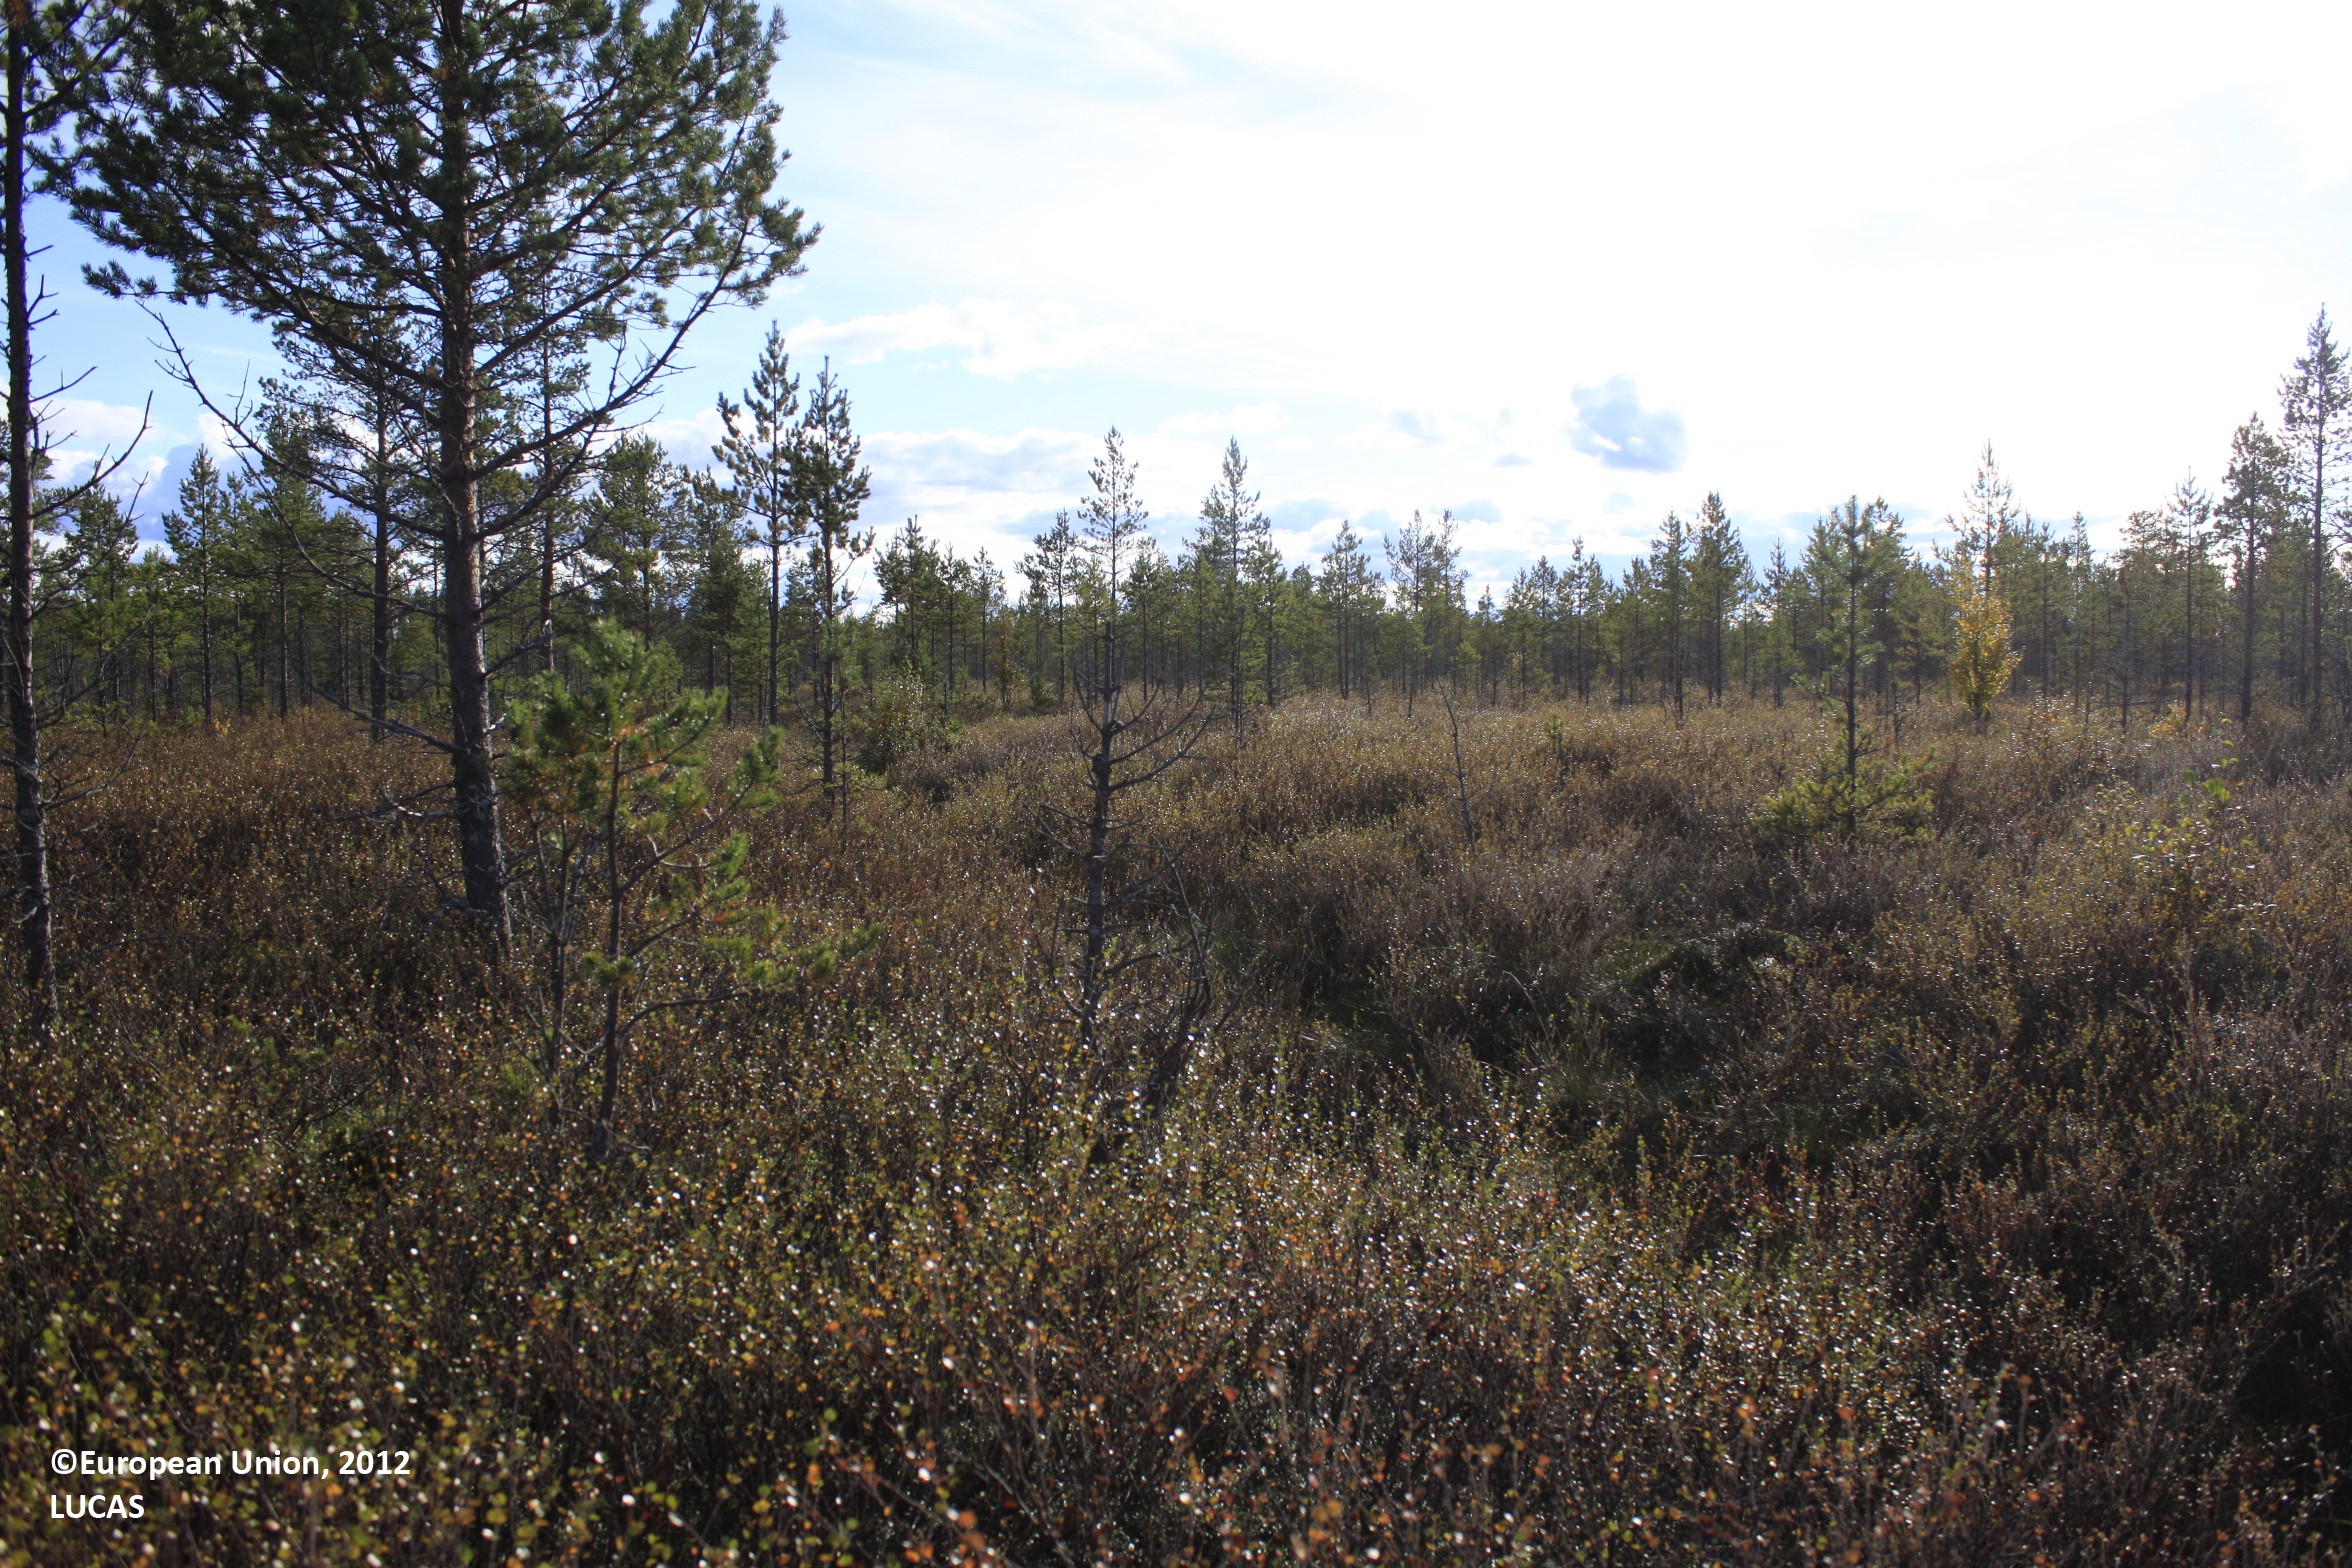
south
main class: Woodland
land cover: Pine dominated coniferous woodland
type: mire and swamp forests
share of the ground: 10 - 25 %
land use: Forestry
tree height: < 5 m
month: September
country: FI
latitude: 65.4712
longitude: 27.0632
